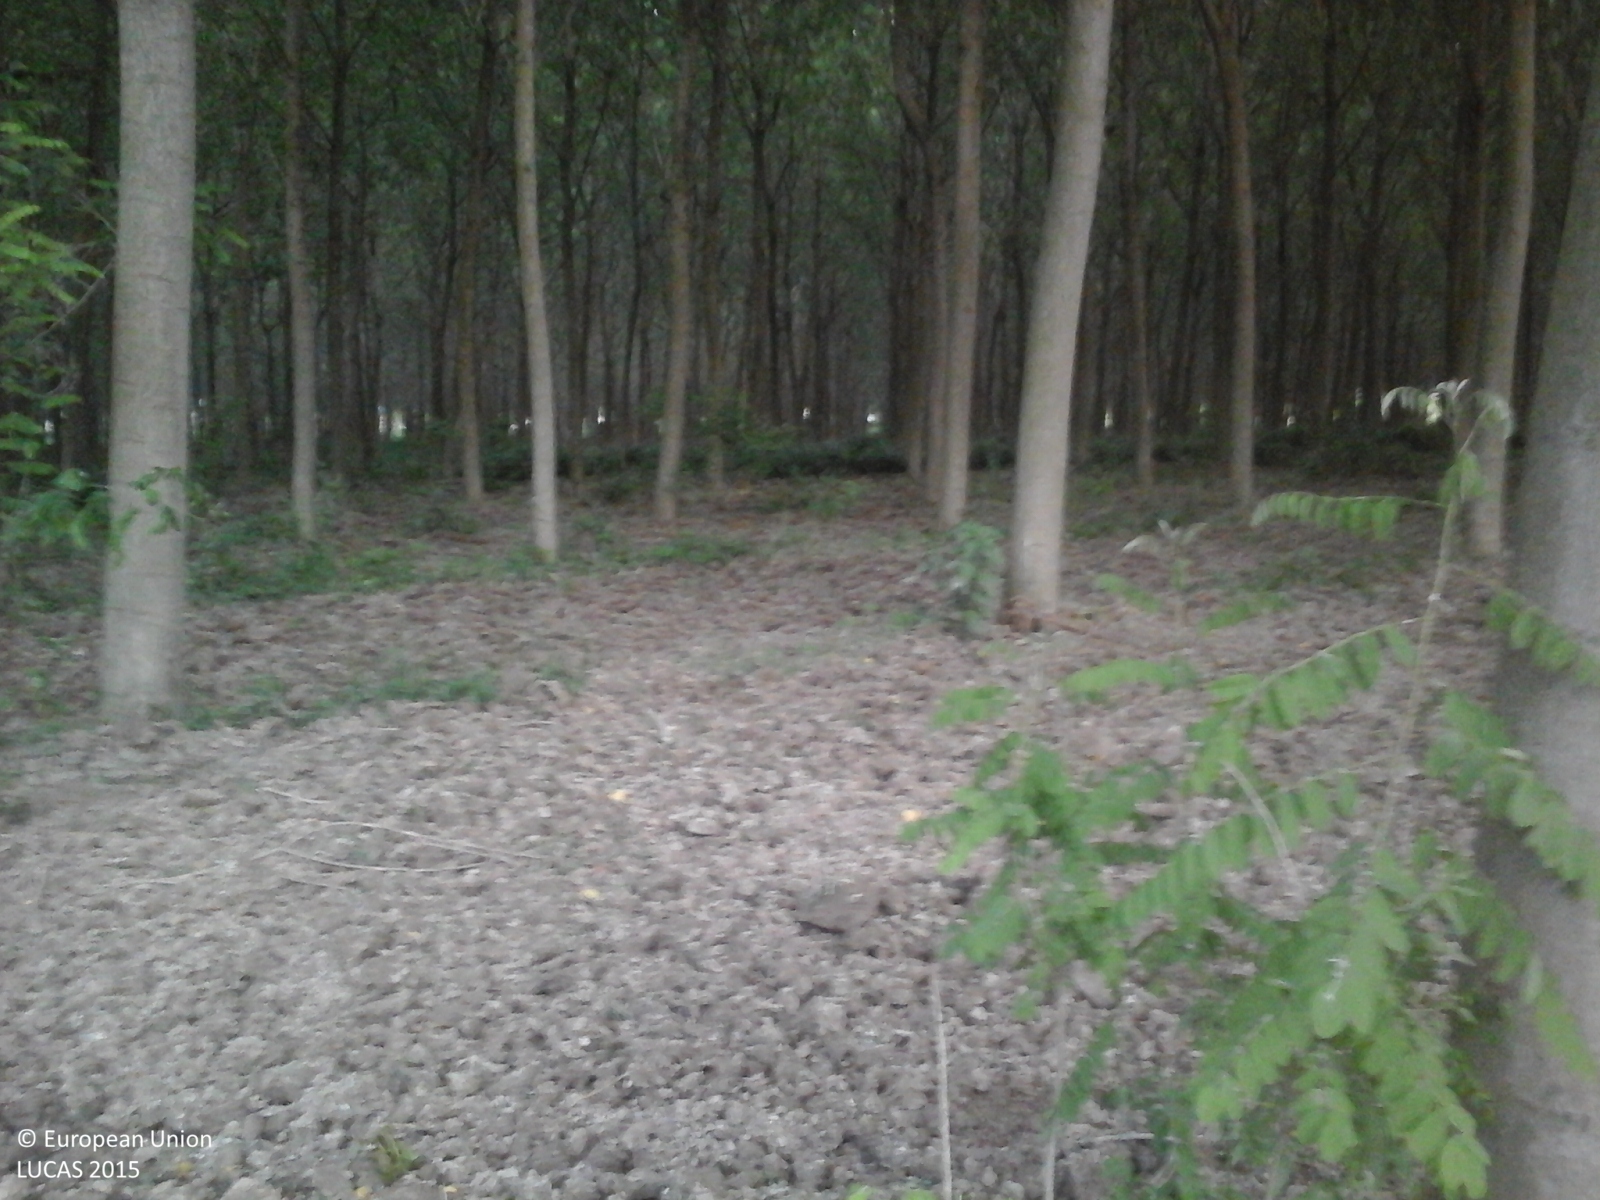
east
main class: Woodland
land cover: Broadleaved woodland
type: non-riverine alder, birch or aspen forest
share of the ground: > 75 %
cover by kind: broadleaved forest trees 100 %
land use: Forestry
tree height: > 5 m
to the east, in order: Broadleaved woodland
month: May
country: IT
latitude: 45.0680
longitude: 10.9000
